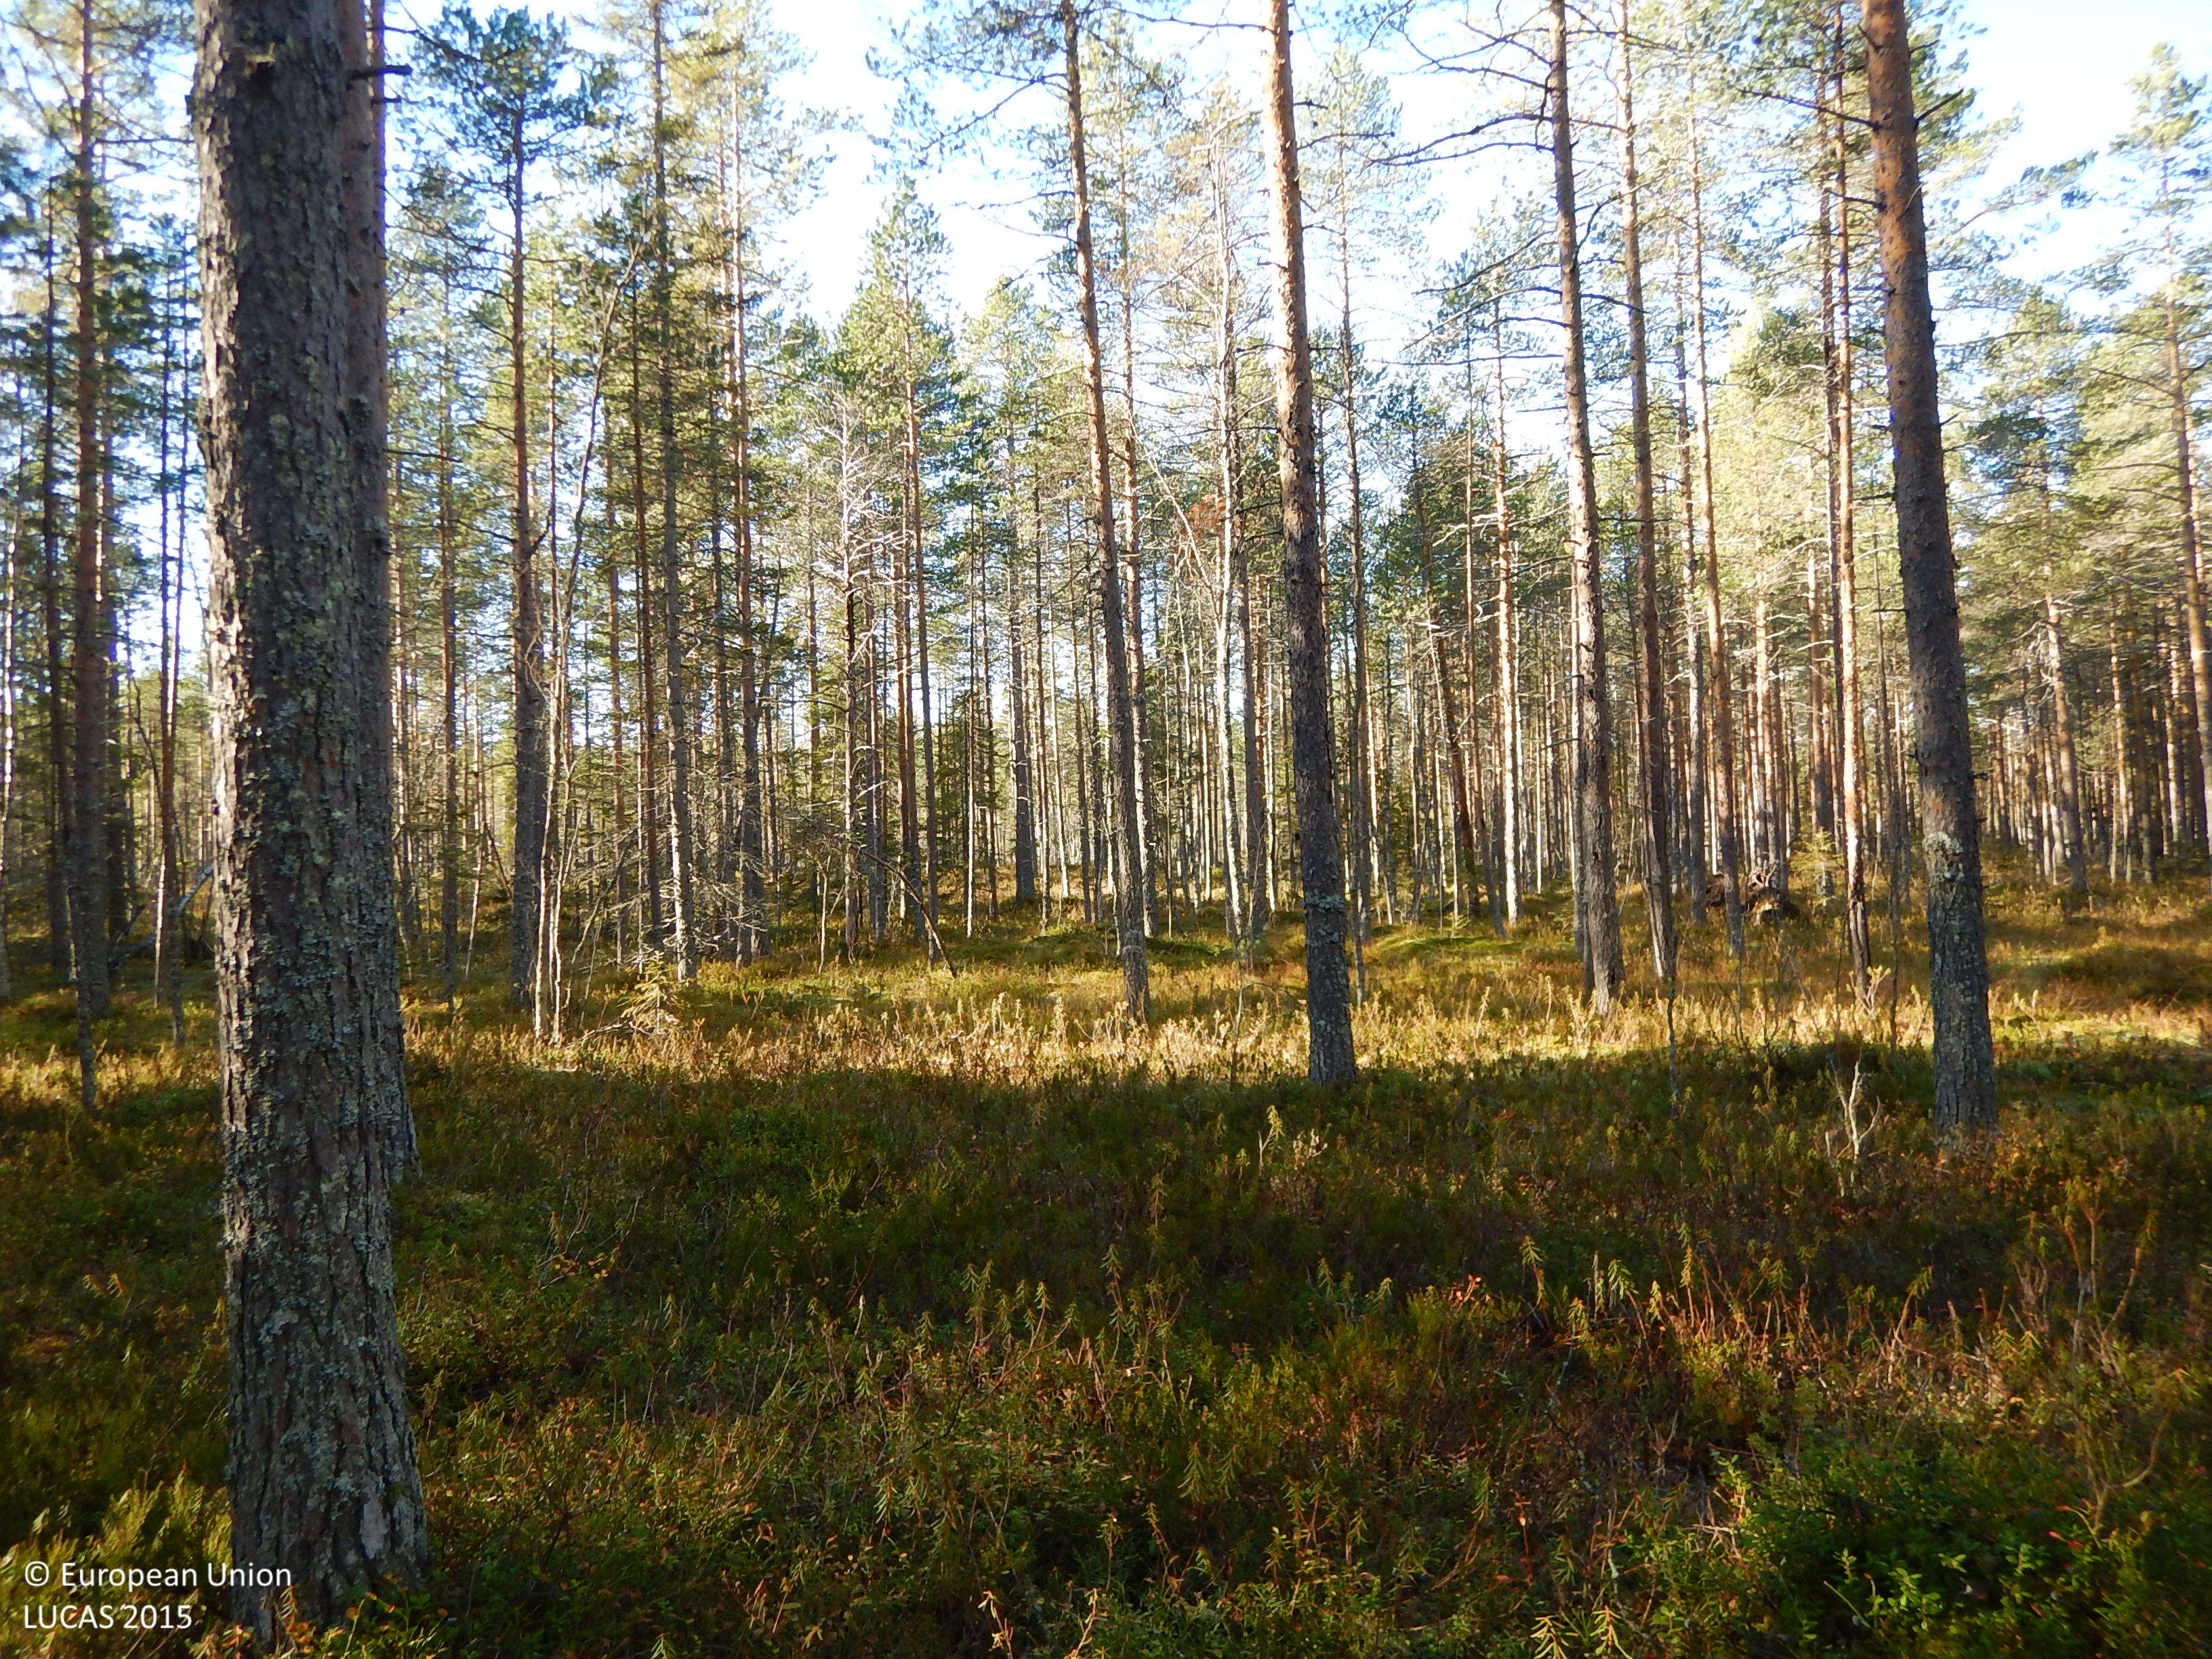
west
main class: Woodland
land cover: Pine dominated coniferous woodland
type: boreal forest
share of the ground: 50 - 75 %
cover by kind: coniferous forest trees 60 %, shrubs 15 %, lichens and mosses 15 %, broadleaved forest trees 5 %, herbaceous plants 5 %
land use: Forestry
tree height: > 5 m
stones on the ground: < 10 %
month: October
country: SE
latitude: 65.0476
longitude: 21.1296
